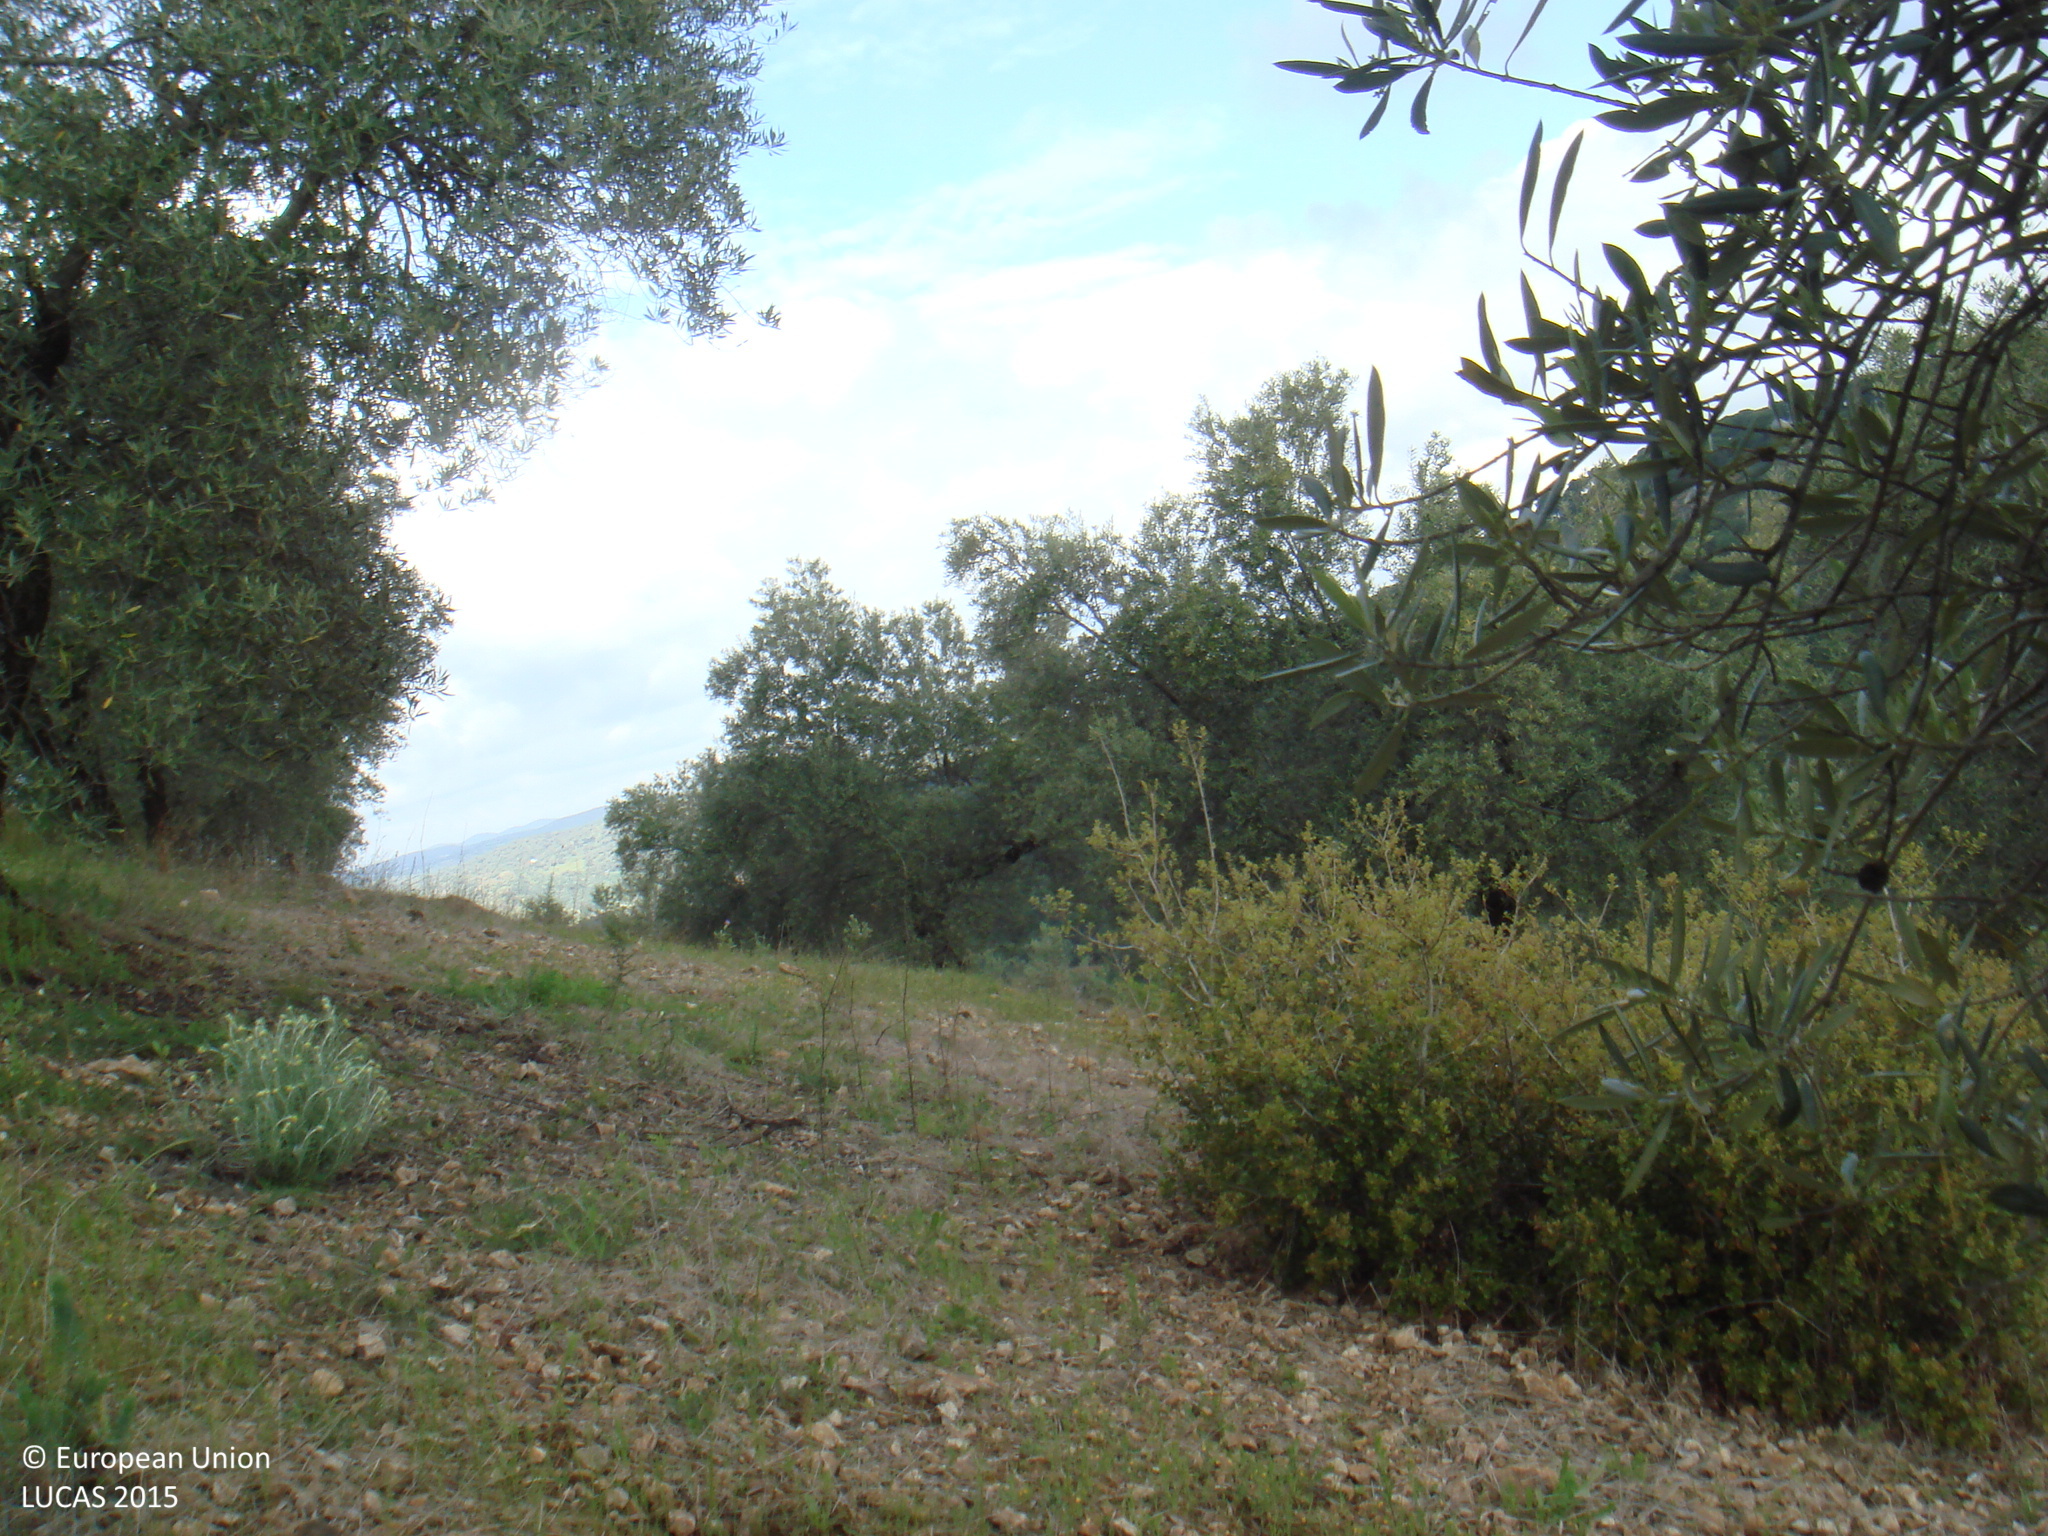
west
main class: Cropland
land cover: Olive groves
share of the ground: 10 - 25 %
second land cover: Spontaneously vegetated surfaces
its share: > 75 %
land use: Agriculture (excluding fallow land and kitchen gardens)
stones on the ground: 10 - 25 %
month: April
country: ES
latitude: 38.0793
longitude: -4.9891
